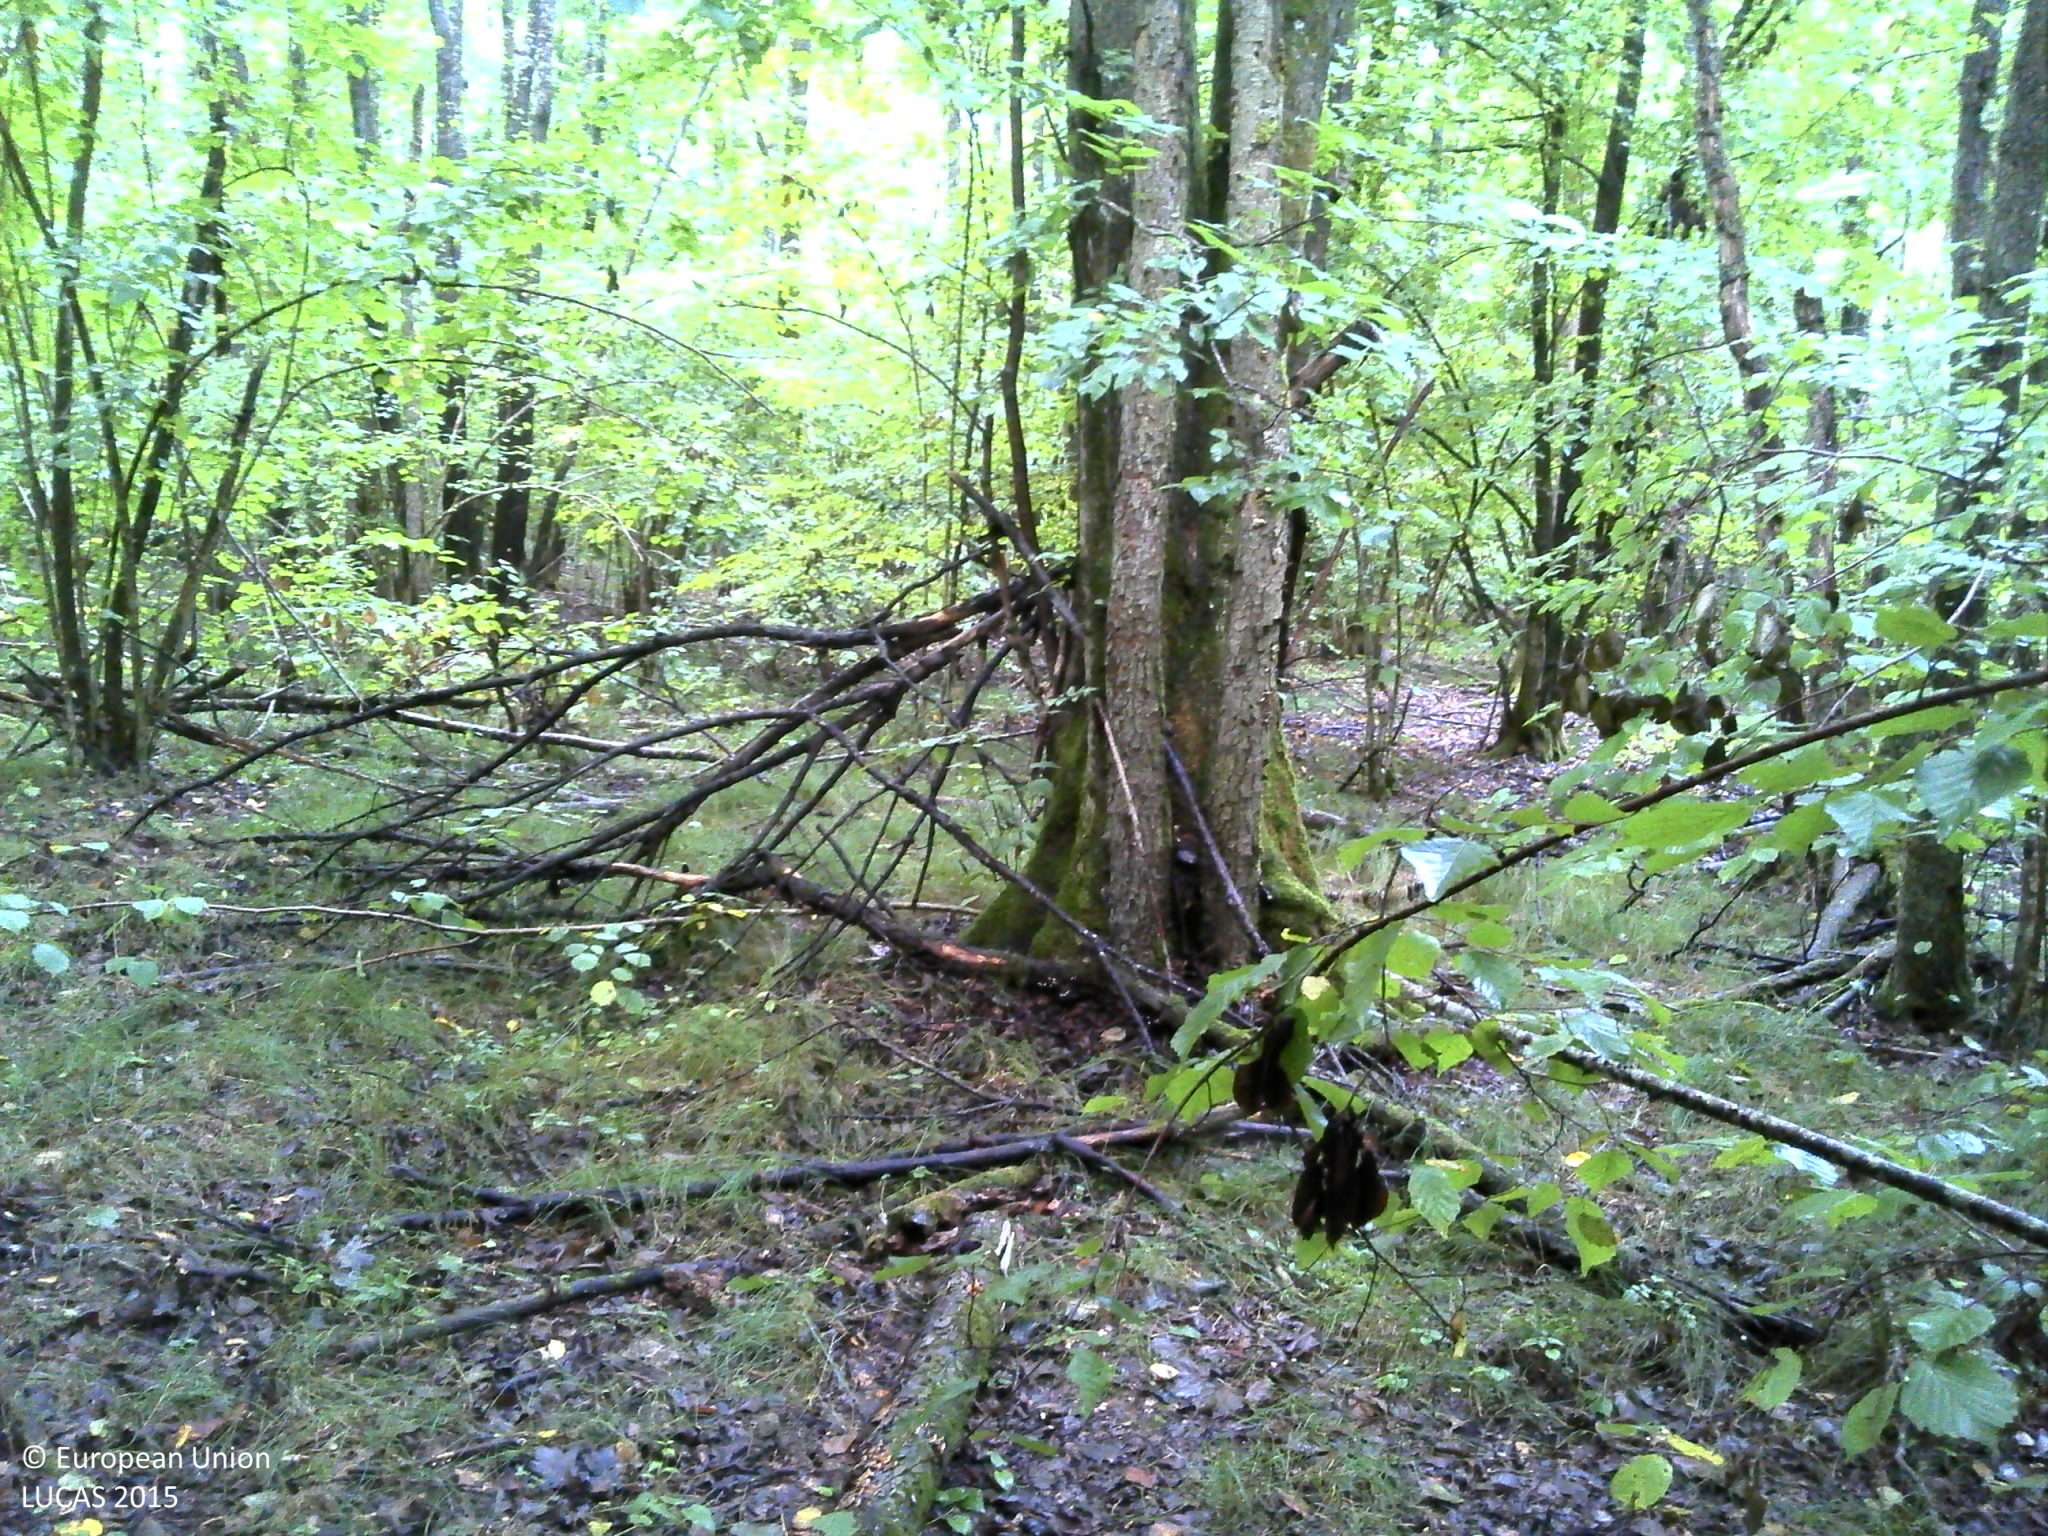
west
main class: Woodland
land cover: Broadleaved woodland
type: mesophytic deciduous forest
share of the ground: > 75 %
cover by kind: broadleaved forest trees 100 %
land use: Forestry
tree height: > 5 m
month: August
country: HR
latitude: 45.5700
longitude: 15.6474
